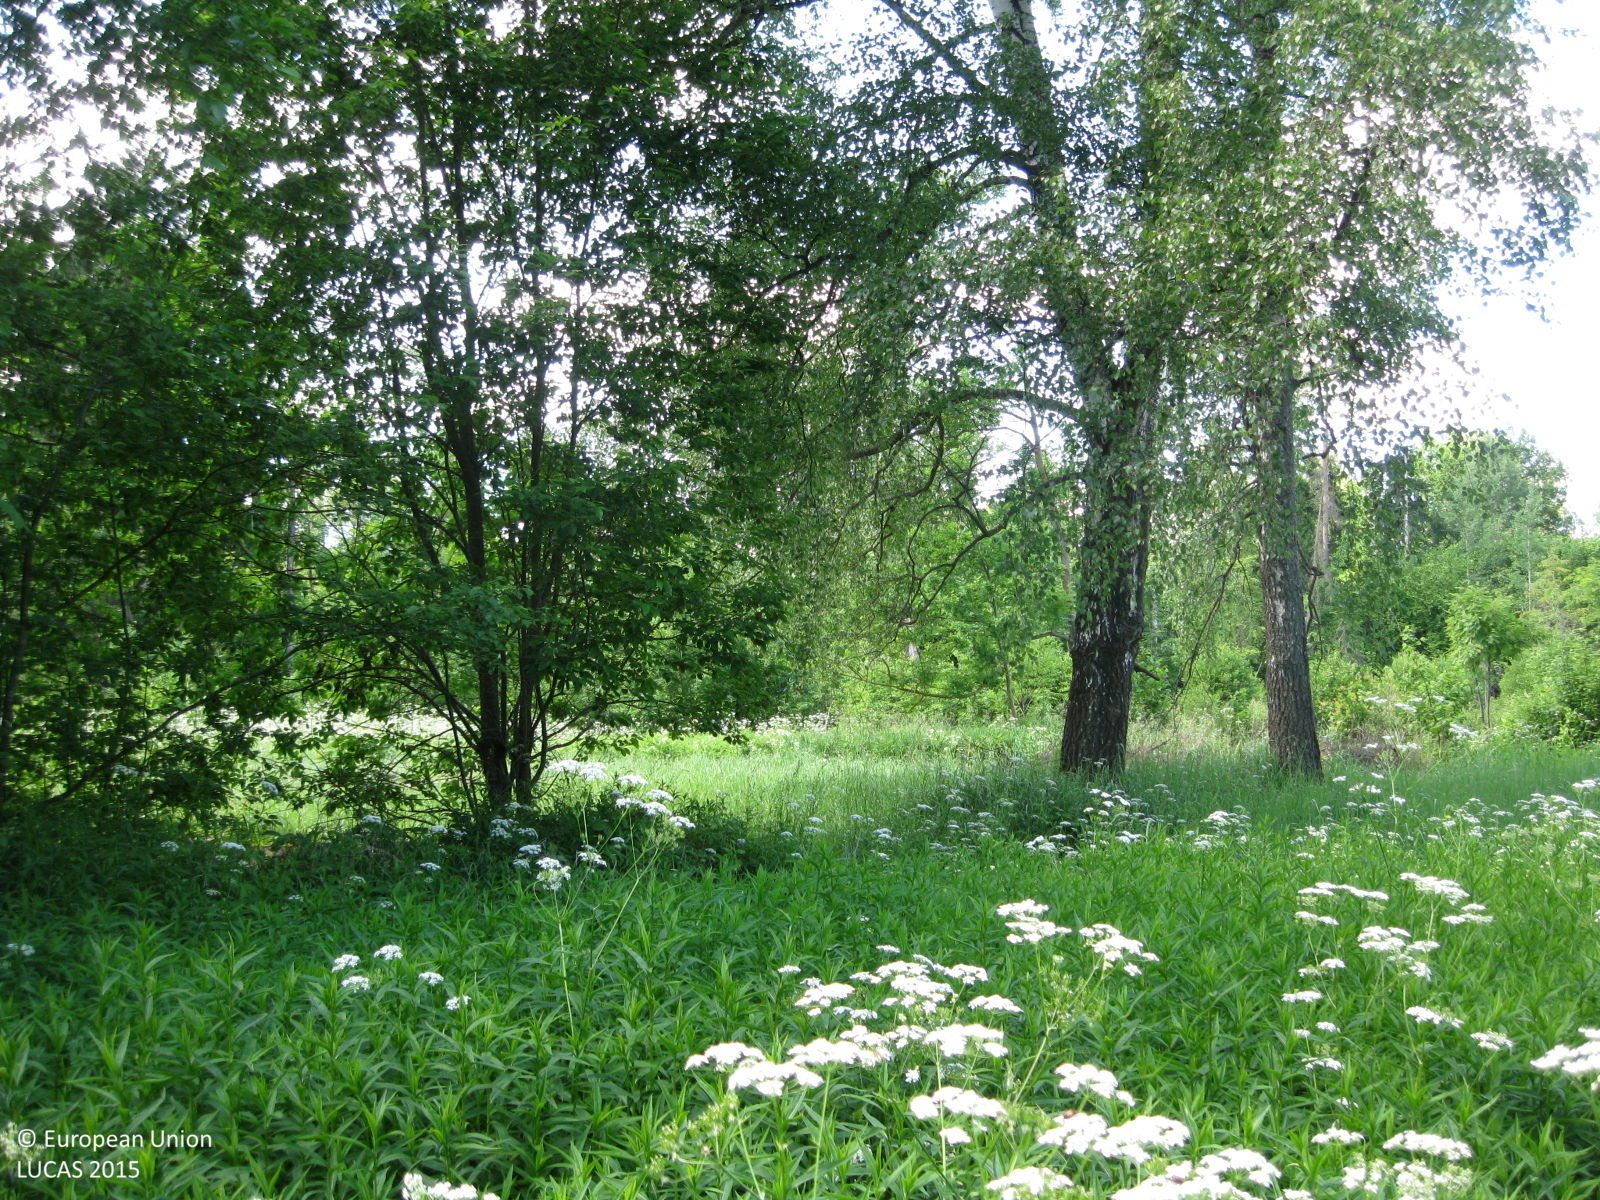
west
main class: Grassland
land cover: Spontaneously vegetated surfaces
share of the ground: > 75 %
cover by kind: herbaceous plants 100 %
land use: Semi-natural and natural areas not in use
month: June
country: LT
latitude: 55.3474
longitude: 23.9502
